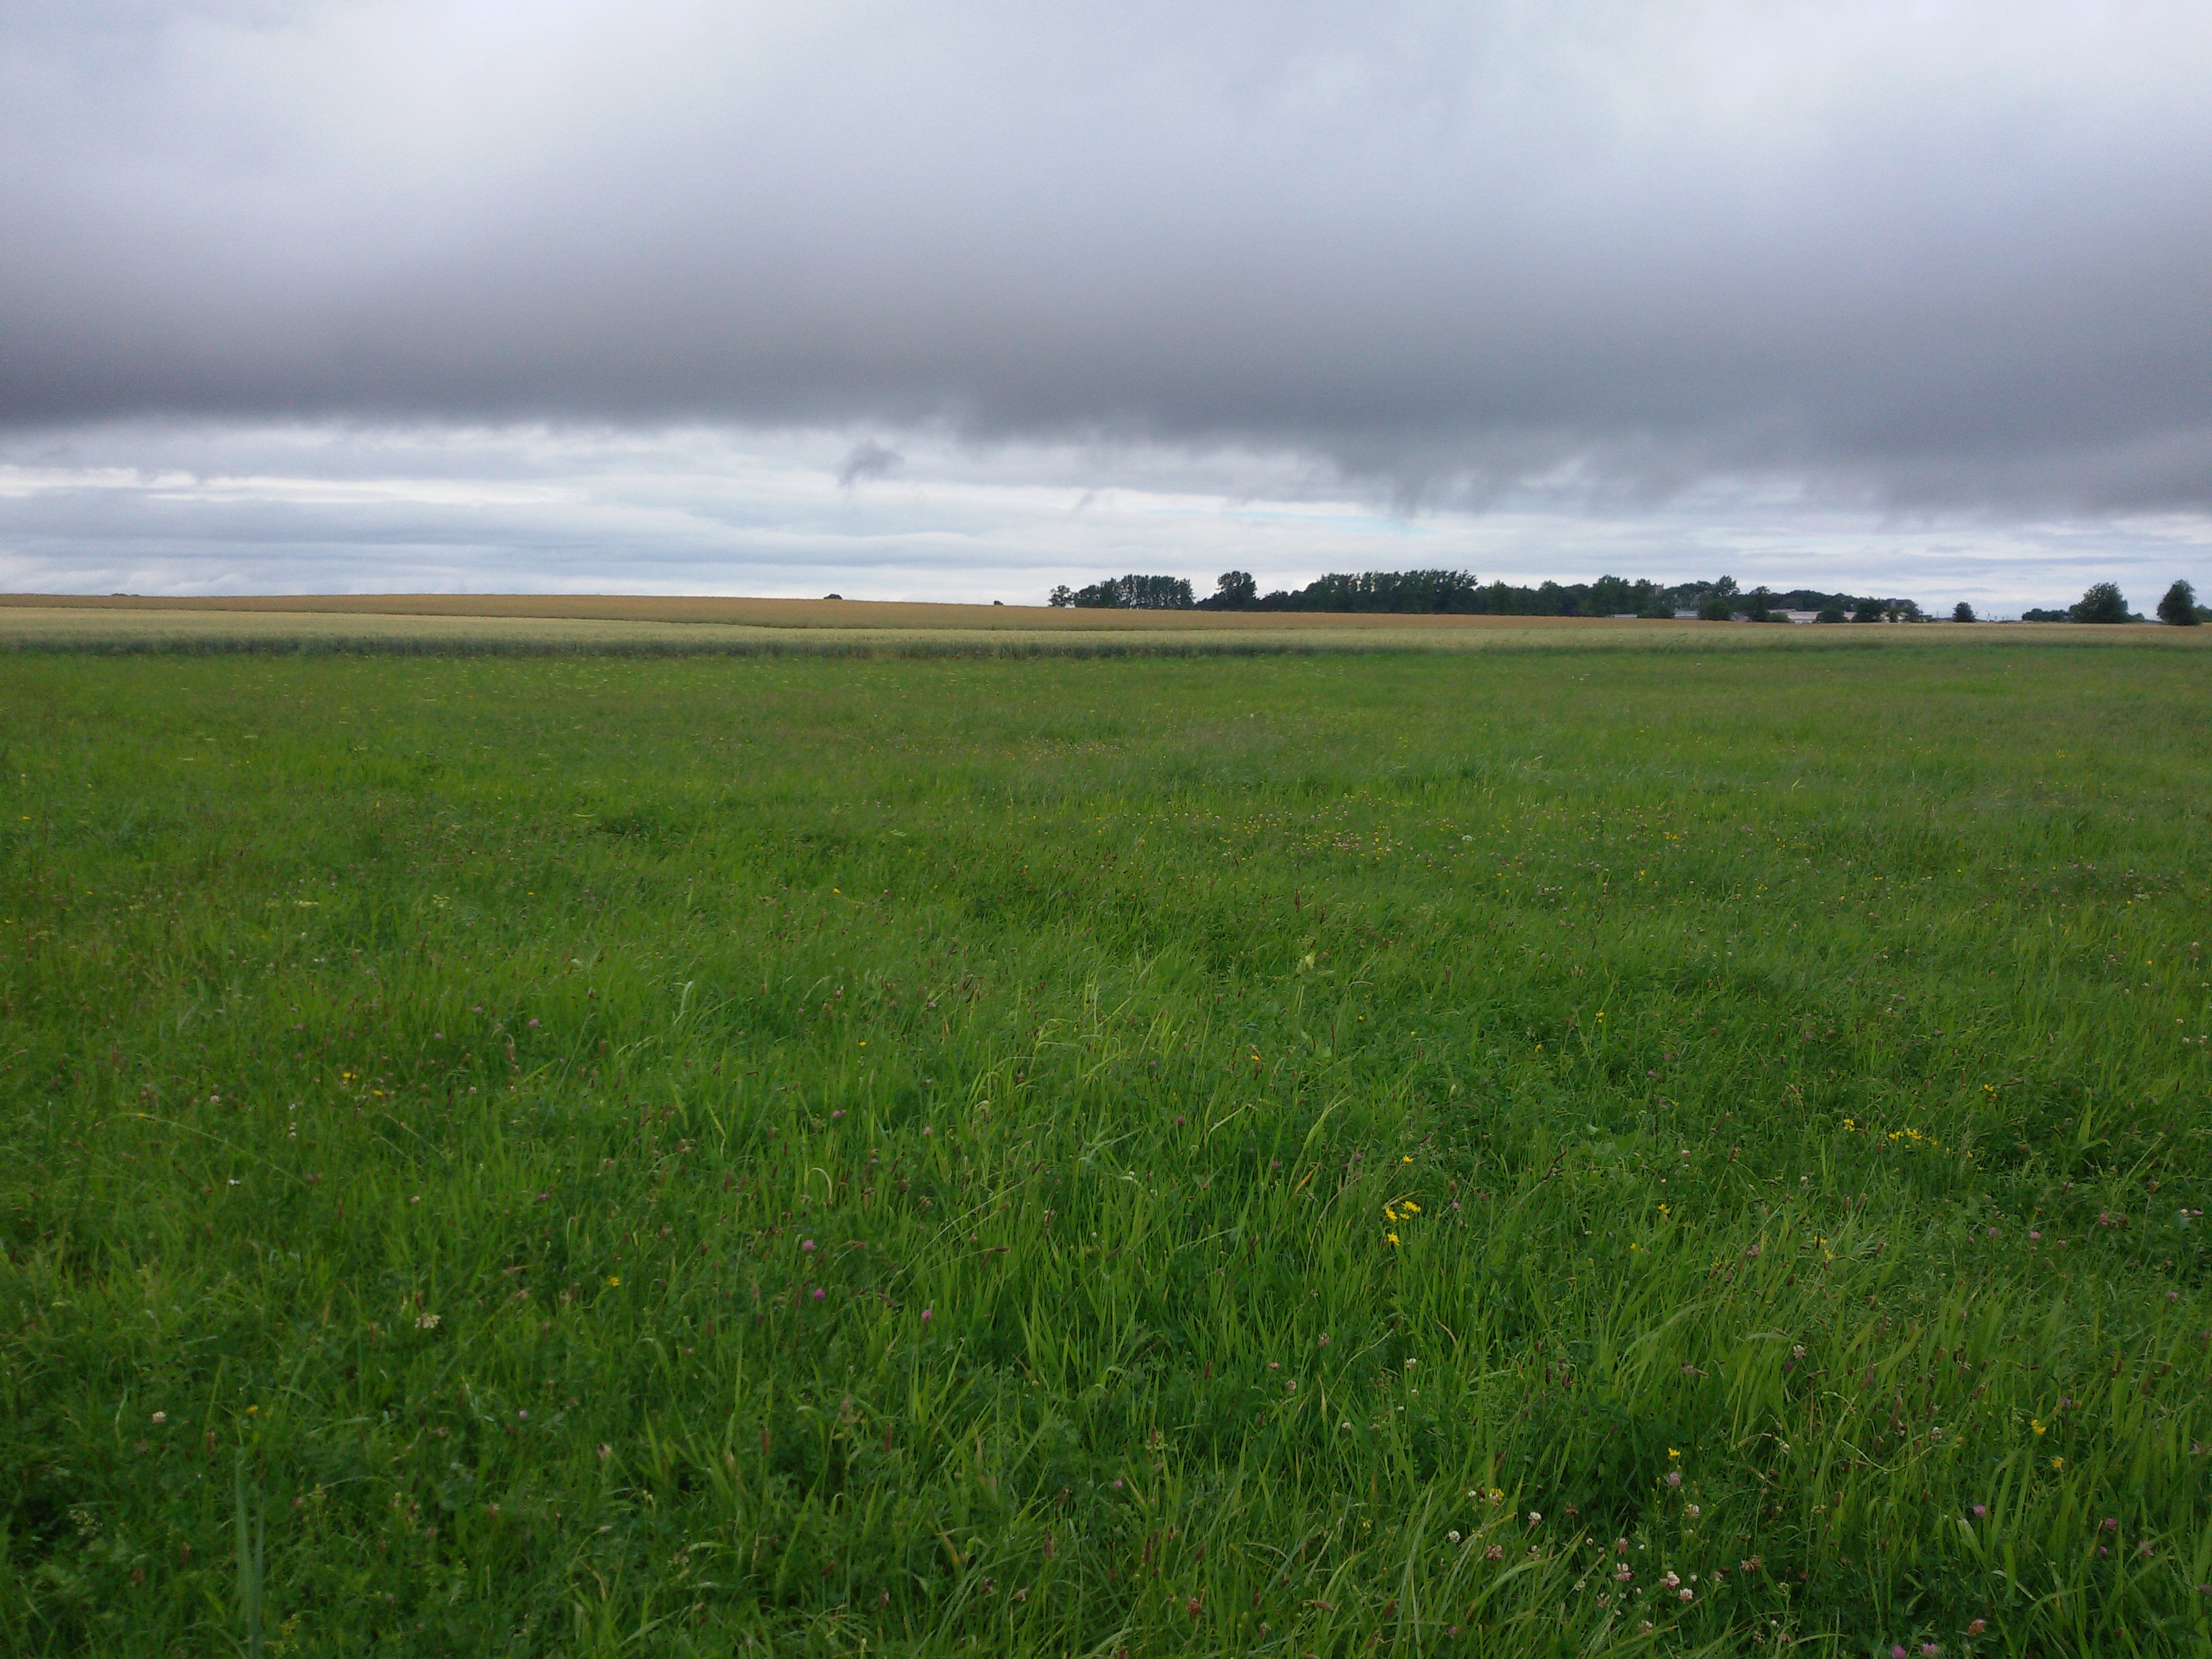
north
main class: Cropland
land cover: Barley
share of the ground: > 75 %
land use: Agriculture (excluding fallow land and kitchen gardens)
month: July
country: PL
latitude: 52.9113
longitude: 17.5816
